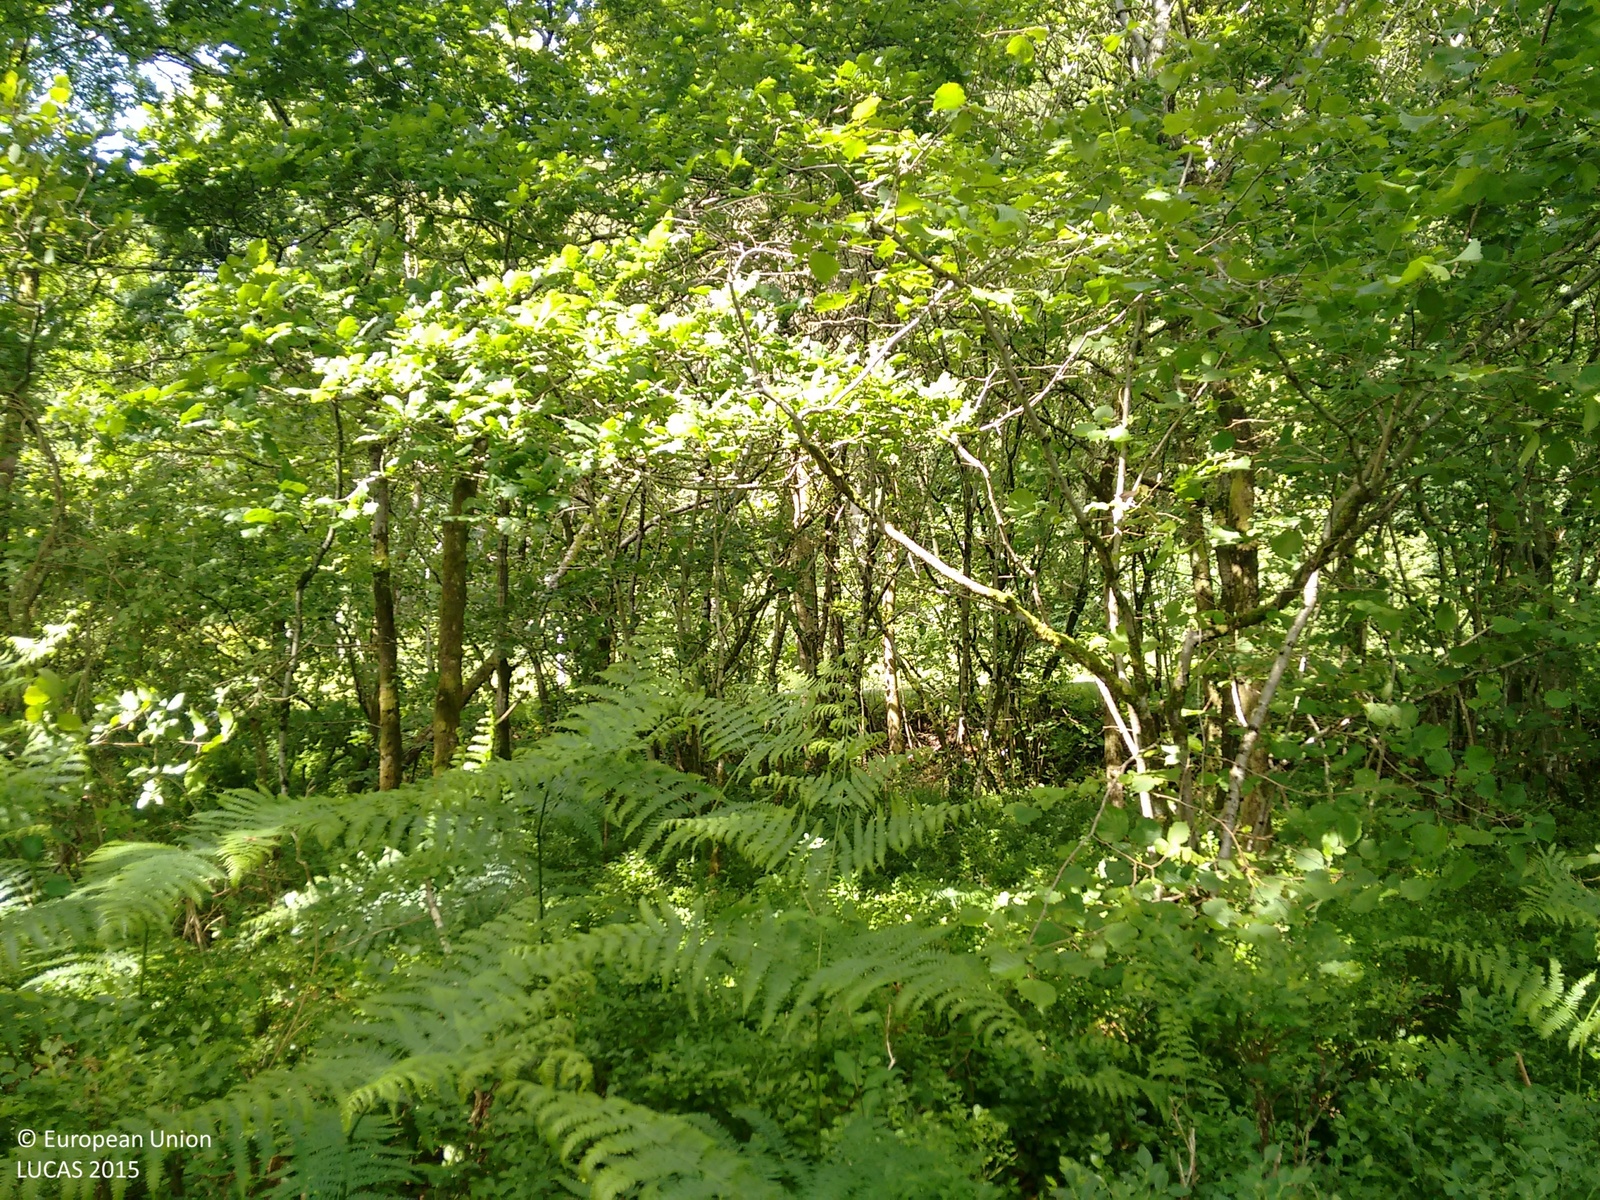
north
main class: Woodland
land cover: Broadleaved woodland
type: acidophilous oak and oak-birch forest
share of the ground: > 75 %
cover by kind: broadleaved forest trees 100 %
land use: Semi-natural and natural areas not in use
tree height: > 5 m
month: July
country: GB
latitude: 55.3261
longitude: -3.8139
